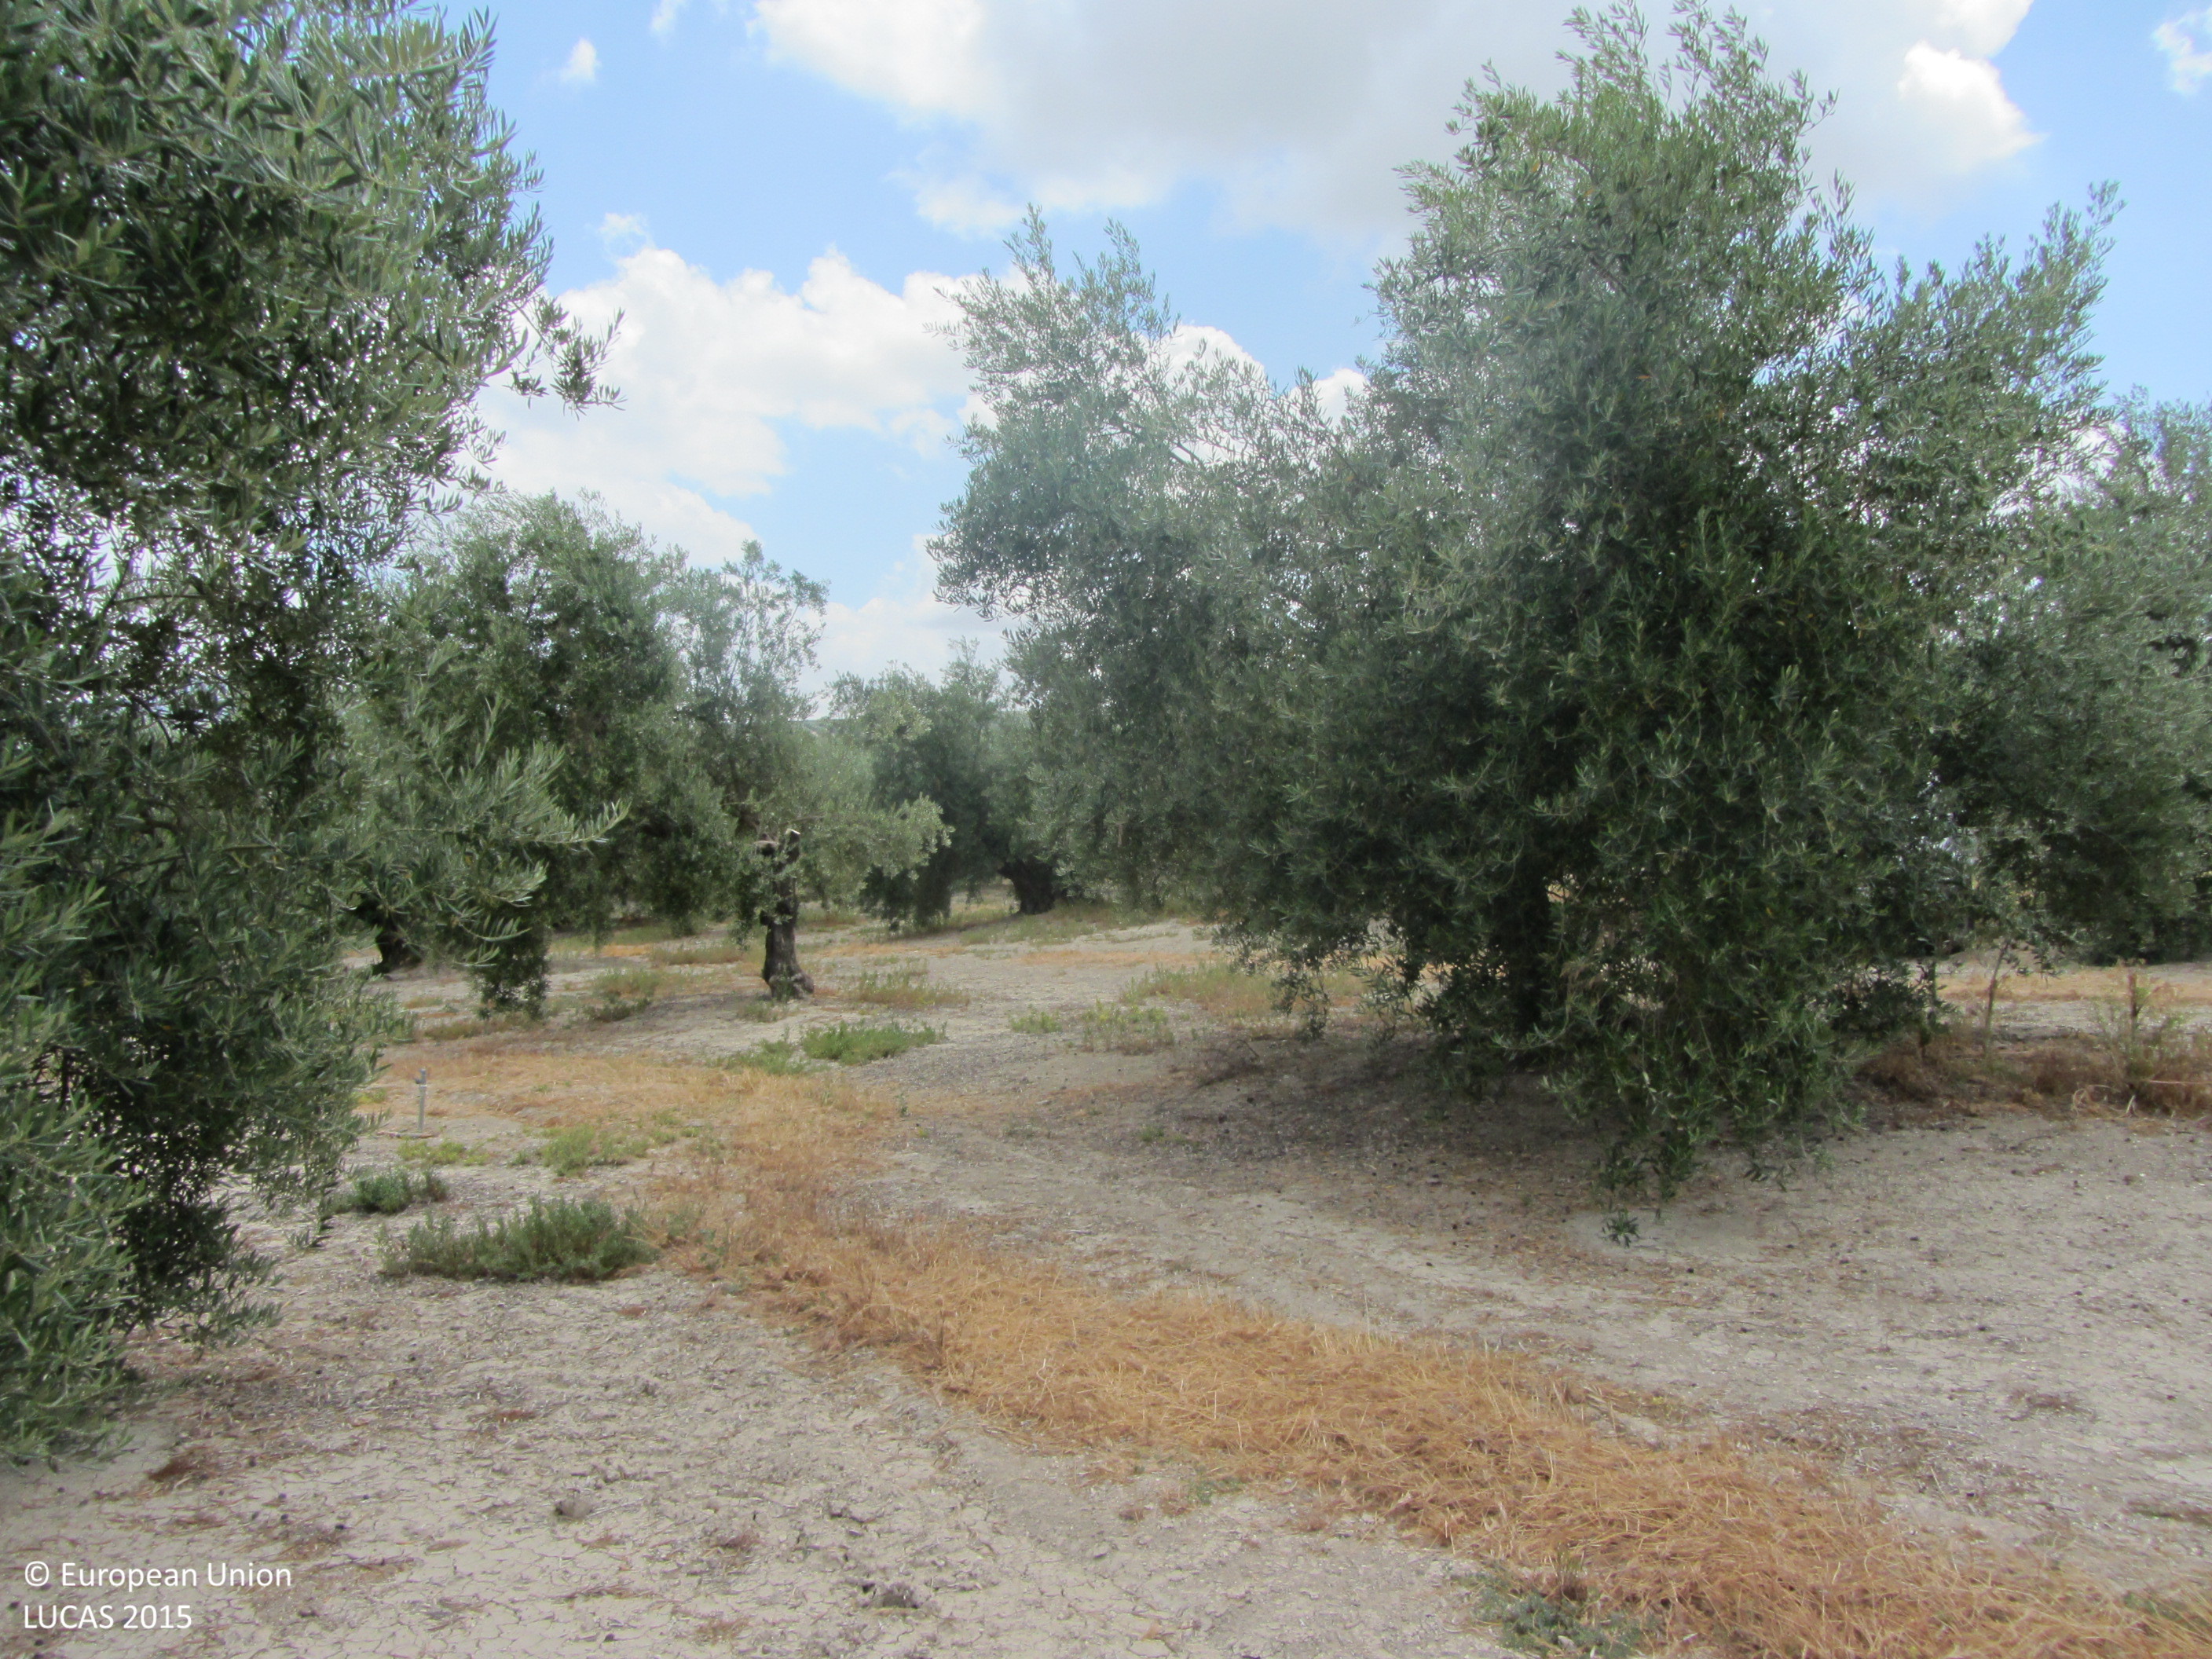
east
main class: Cropland
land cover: Olive groves
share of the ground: 25 - 50 %
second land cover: Other bare soil
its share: > 75 %
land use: Agriculture (excluding fallow land and kitchen gardens)
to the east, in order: Olive groves; Other bare soil; Managed hedges; Ditches and canals; Tracks
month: June
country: ES
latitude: 38.1380
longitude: -3.1088
